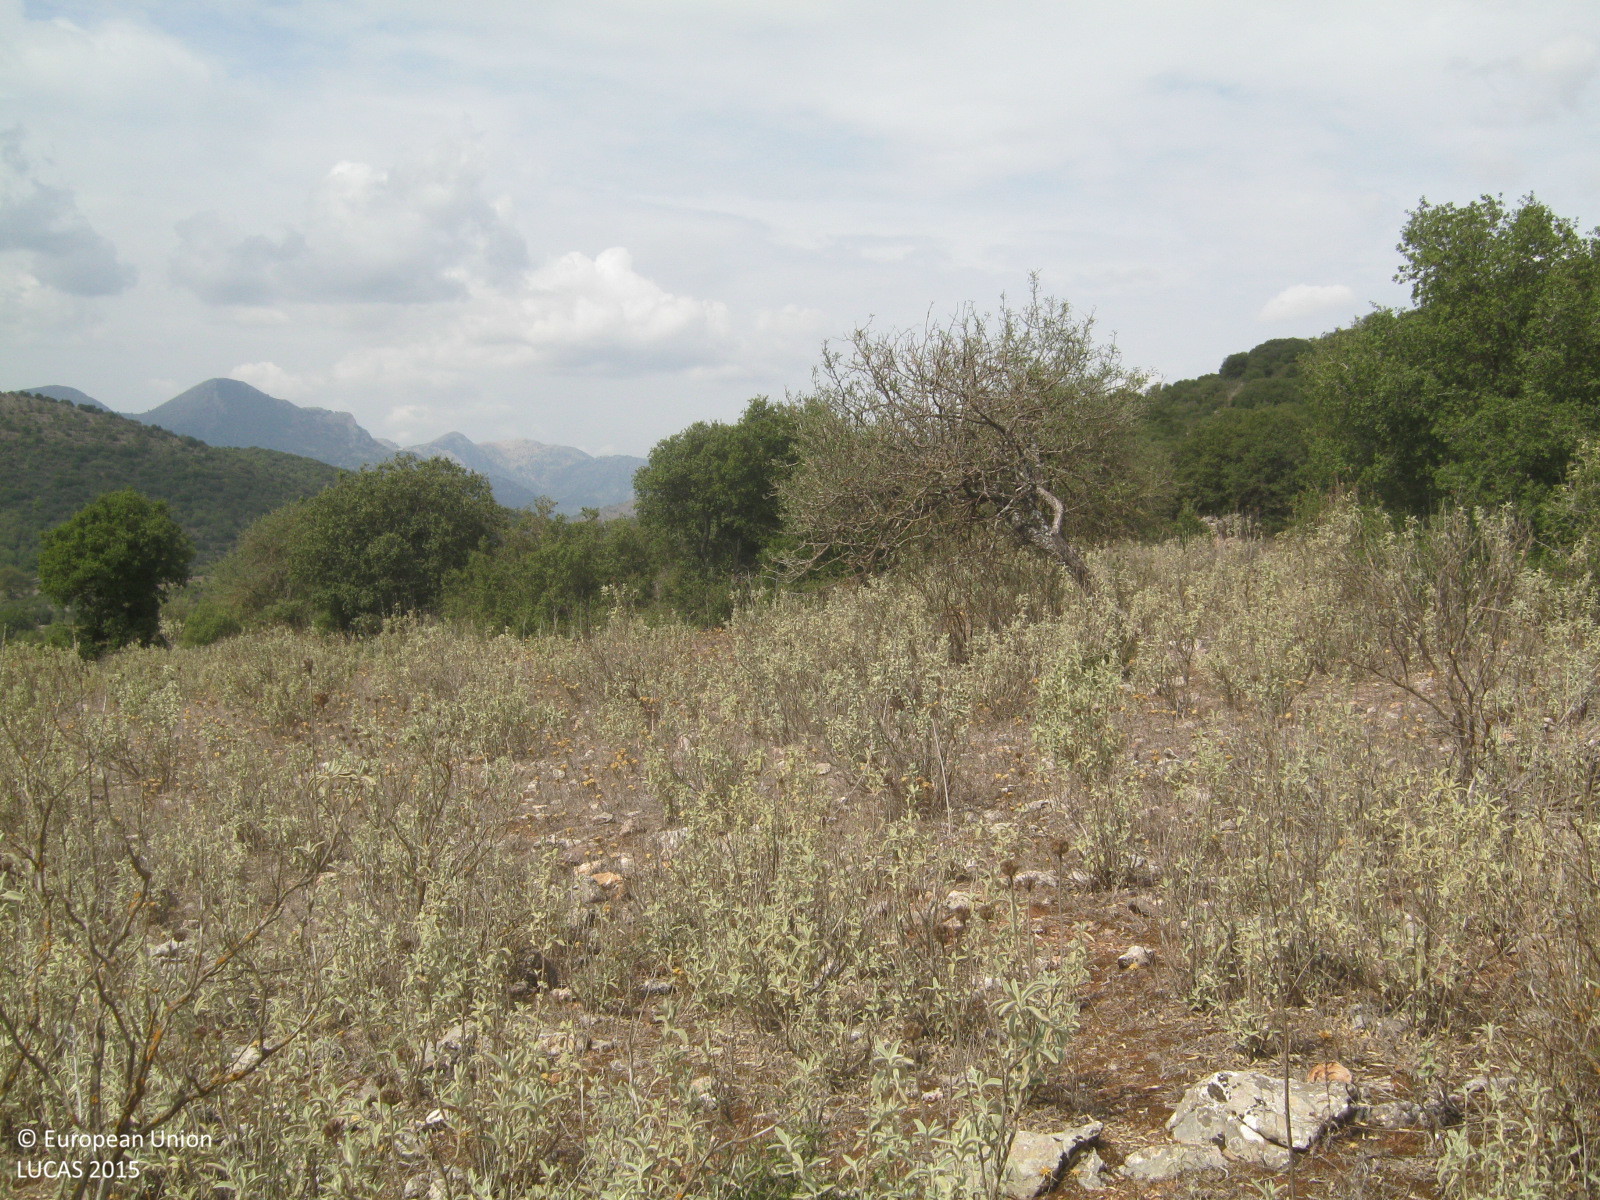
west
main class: Grassland
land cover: Grassland with sparse tree/shrub cover
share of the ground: 50 - 75 %
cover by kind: herbaceous plants 50 %, unconsolidated bare surface 35 %, shrubs 10 %, broadleaved forest trees 5 %
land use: Agriculture (excluding fallow land and kitchen gardens)
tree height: < 5 m
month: September
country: GR
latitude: 37.8370
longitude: 22.0657
